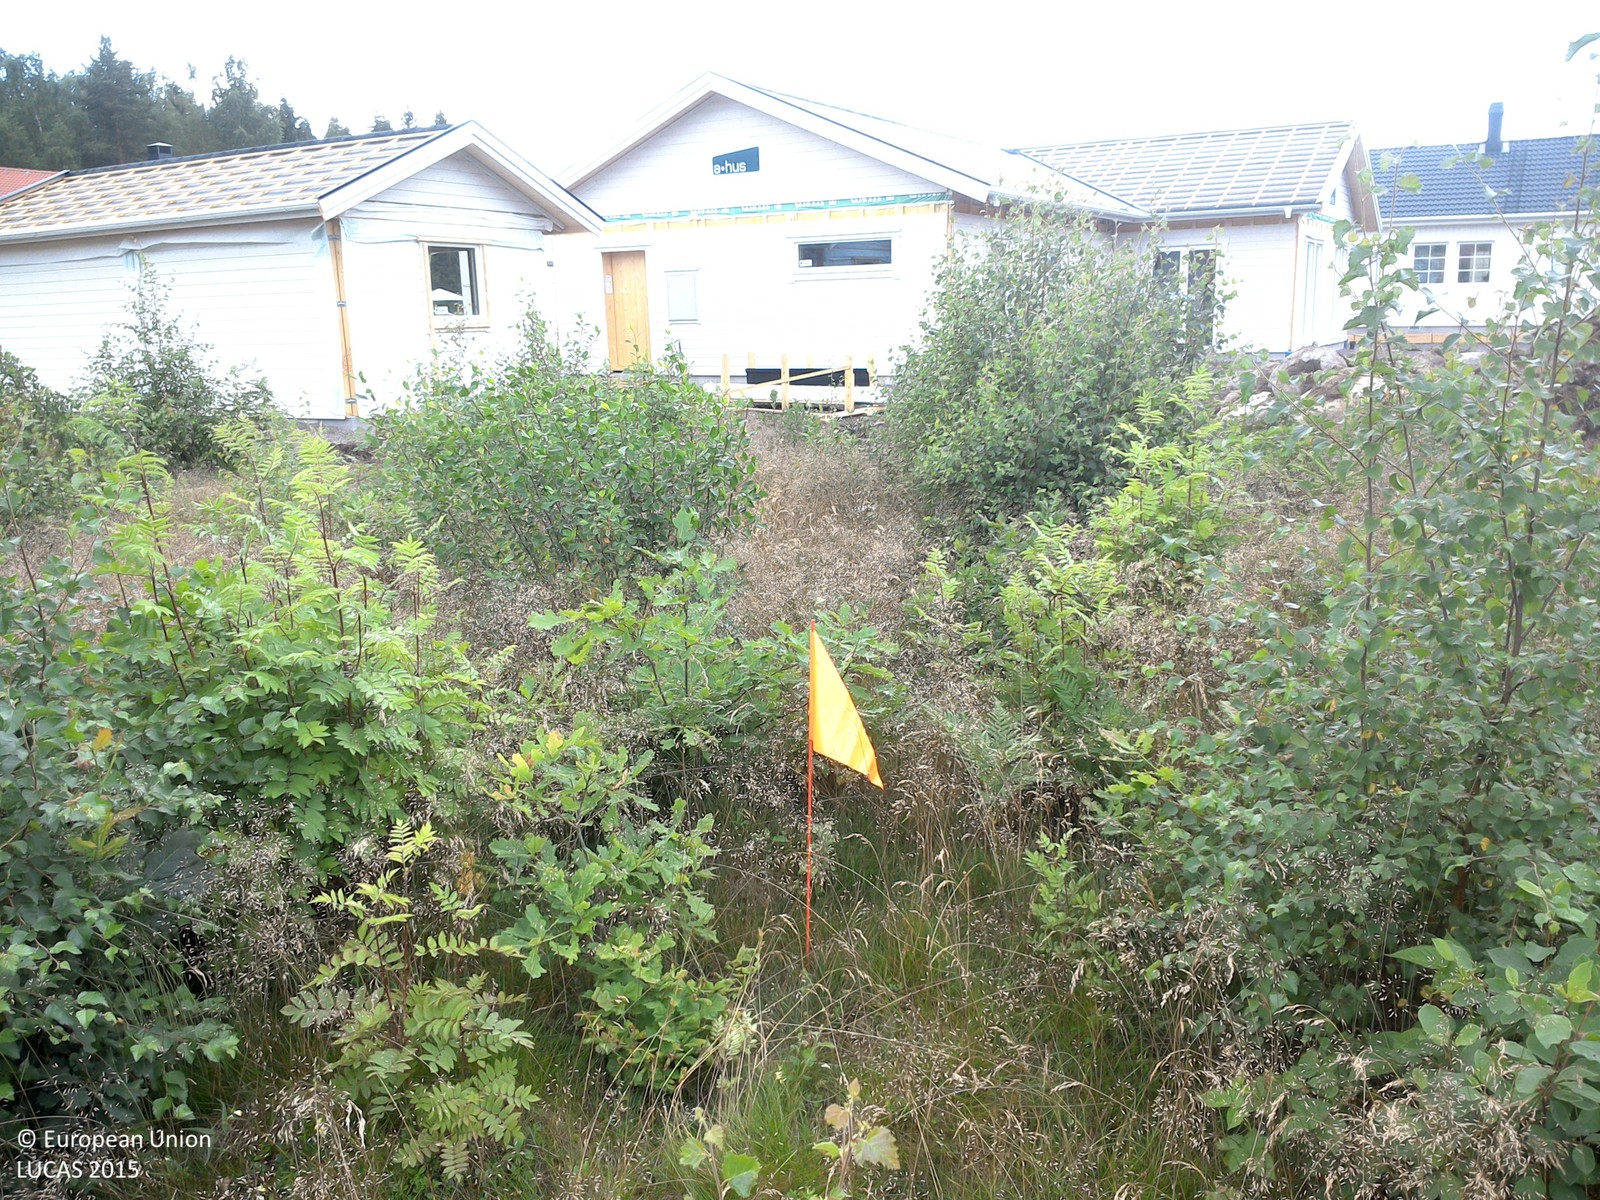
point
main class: Grassland
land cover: Grassland with sparse tree/shrub cover
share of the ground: > 75 %
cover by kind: herbaceous plants 90 %, broadleaved forest trees 5 %, shrubs 5 %
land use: Residential
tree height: > 5 m
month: July
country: SE
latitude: 58.5581
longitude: 15.0295
